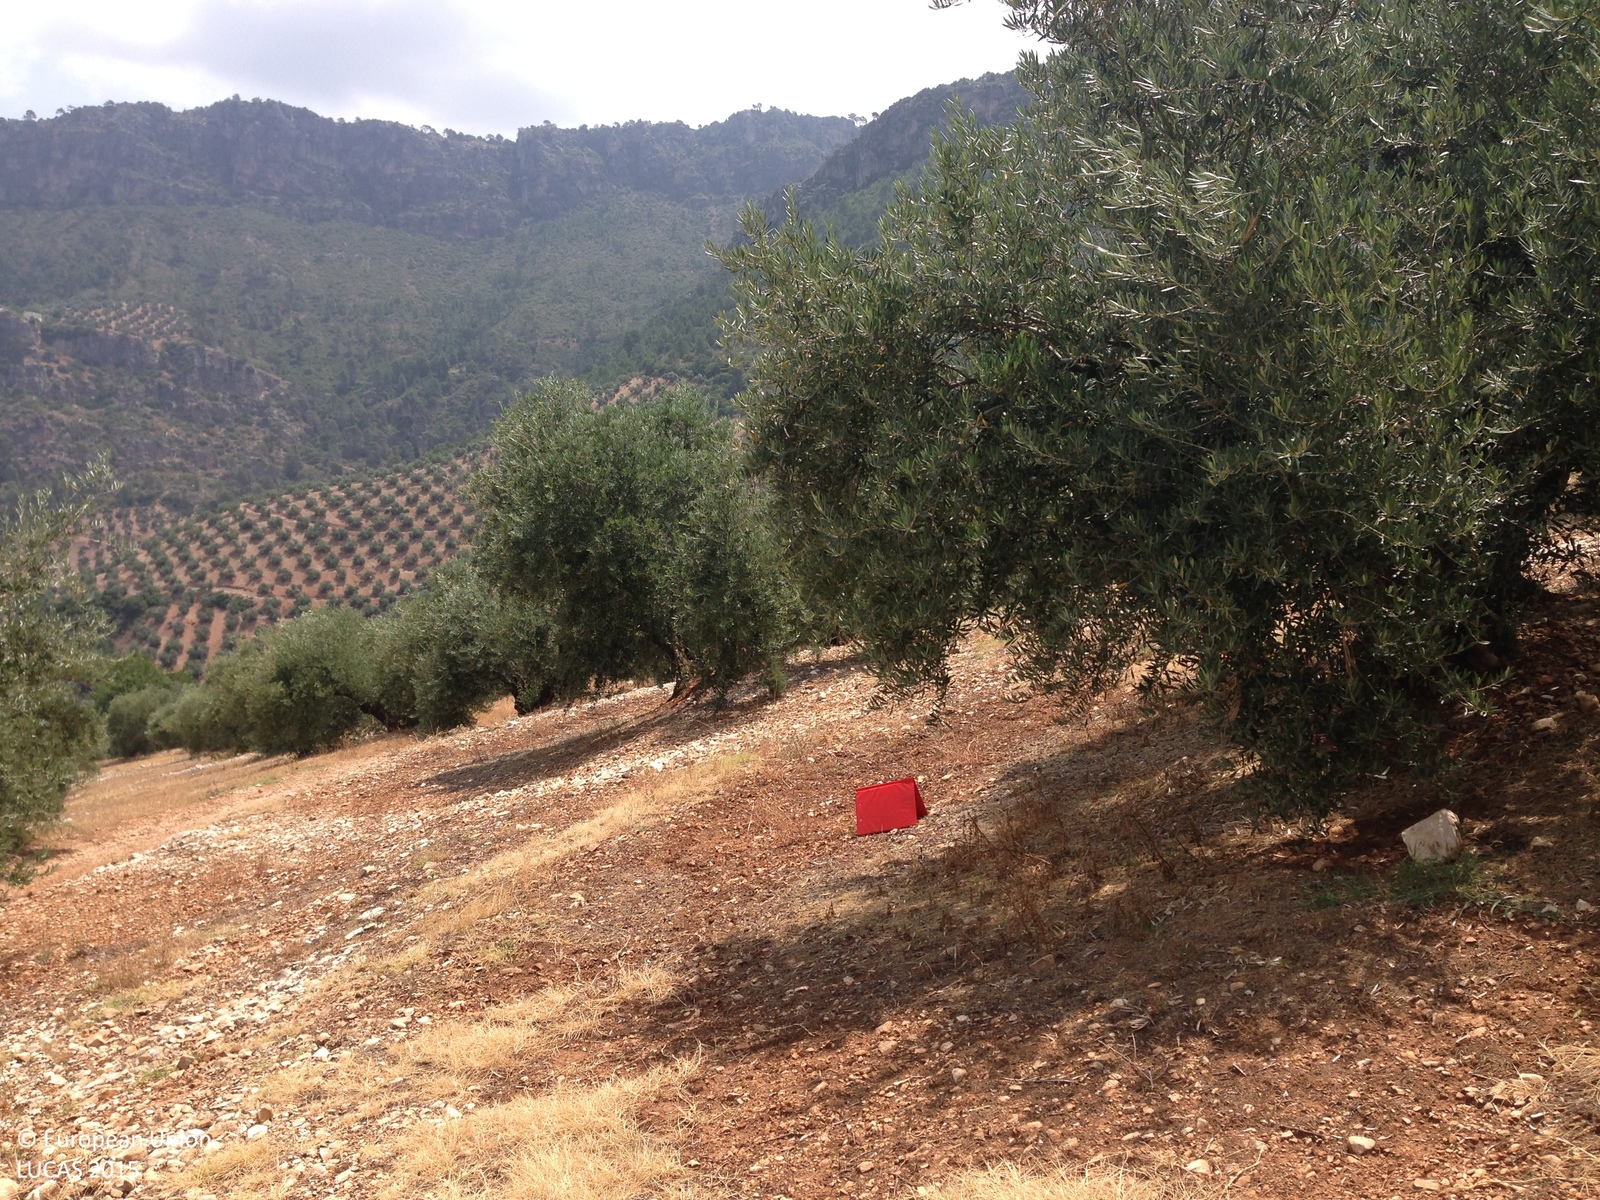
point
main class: Cropland
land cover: Olive groves
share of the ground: 25 - 50 %
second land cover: Other bare soil
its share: > 75 %
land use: Agriculture (excluding fallow land and kitchen gardens)
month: June
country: ES
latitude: 38.1657
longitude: -2.9068
